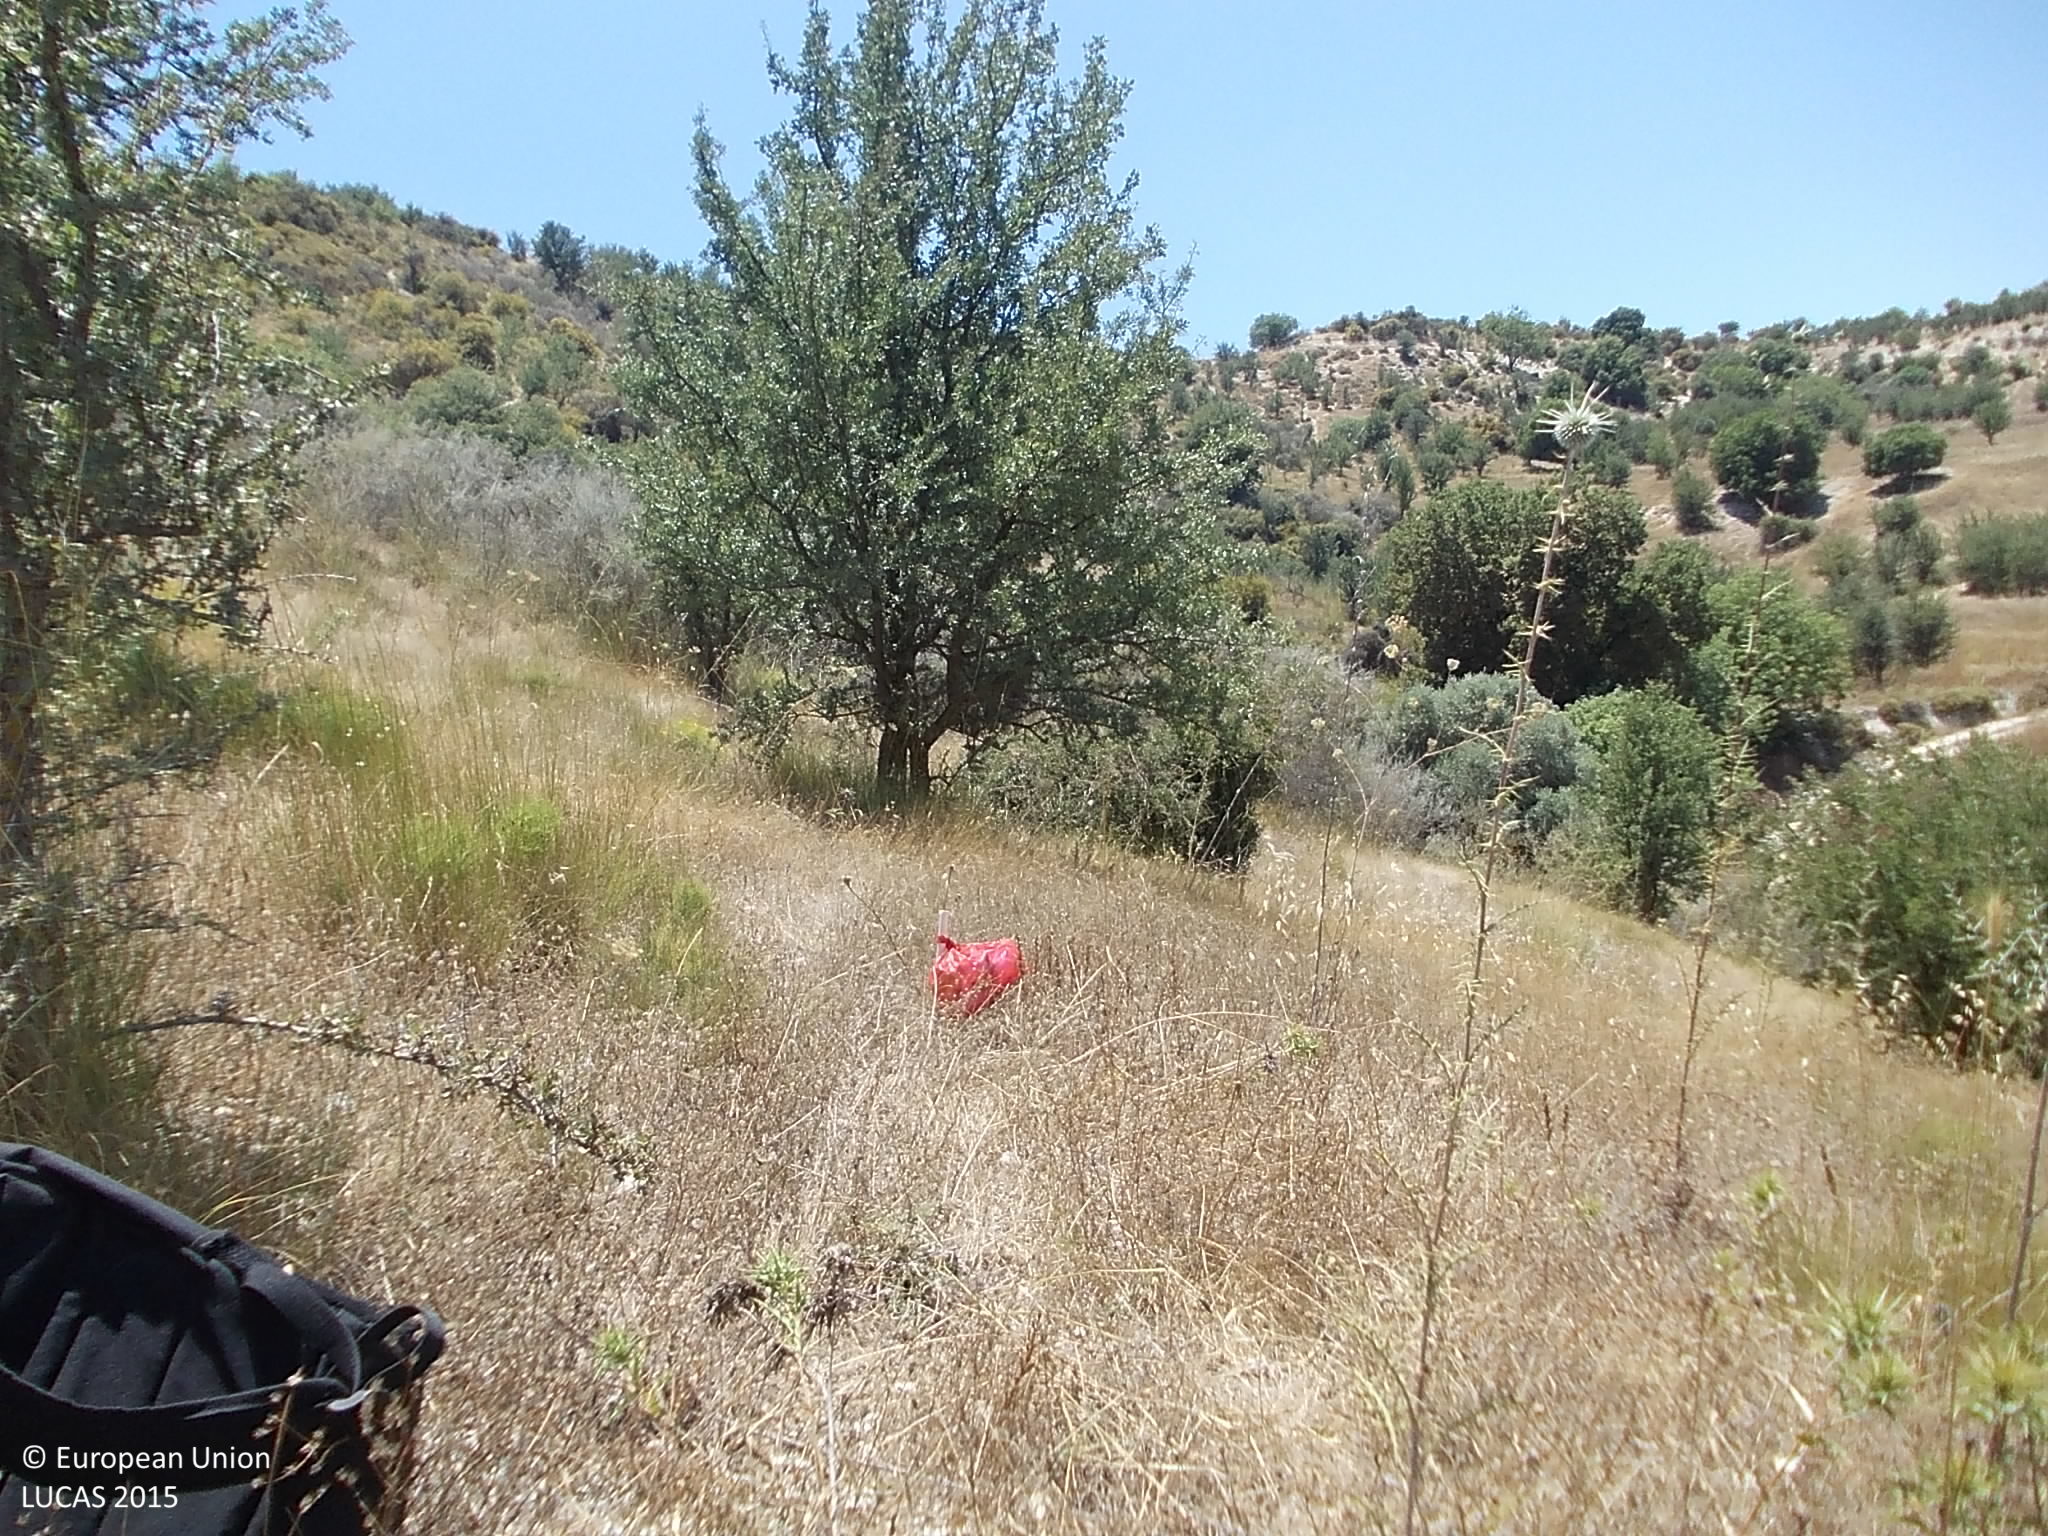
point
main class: Grassland
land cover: Grassland with sparse tree/shrub cover
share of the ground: > 75 %
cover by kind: herbaceous plants 85 %, broadleaved forest trees 5 %, shrubs 5 %, unconsolidated bare surface 5 %
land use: Semi-natural and natural areas not in use
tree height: < 5 m
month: July
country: CY
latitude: 34.8064
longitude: 32.7297
